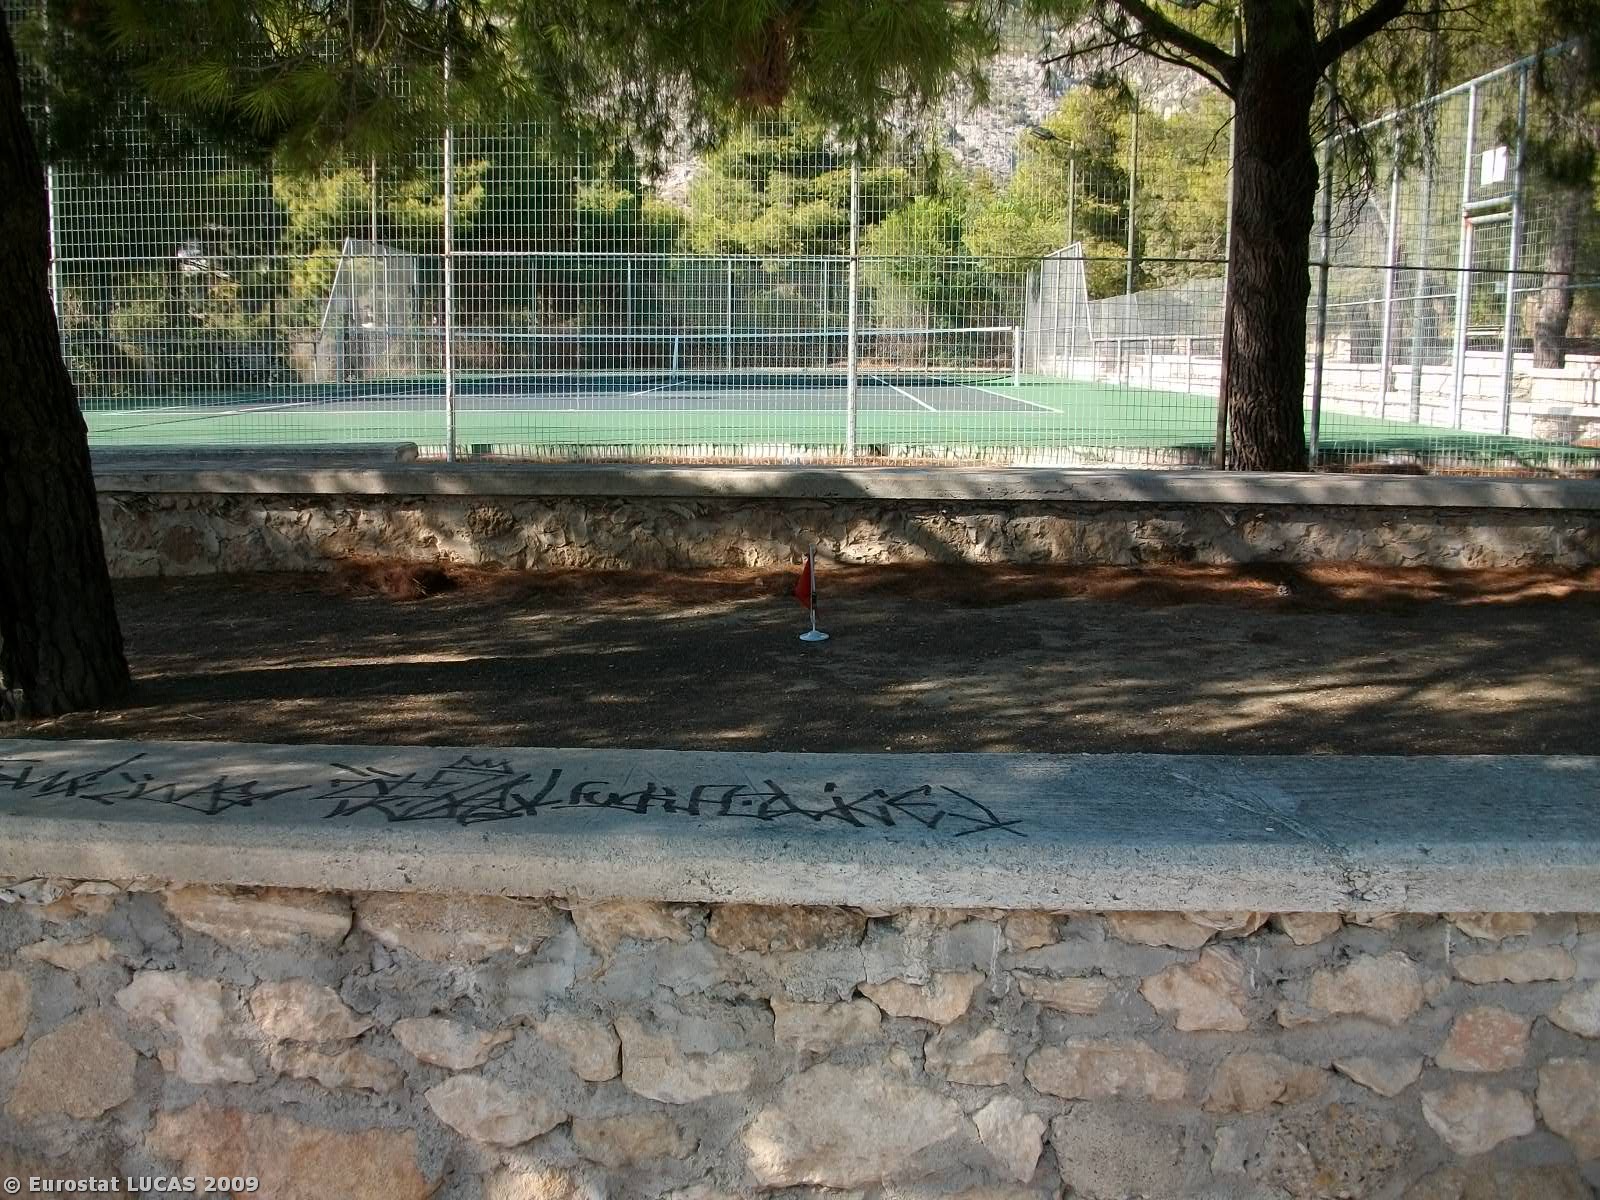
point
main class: Woodland
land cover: Coniferous woodland
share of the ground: > 75 %
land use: Amenities, museums, leisure
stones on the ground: < 10 %
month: September
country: GR
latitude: 37.9718
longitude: 22.9845
